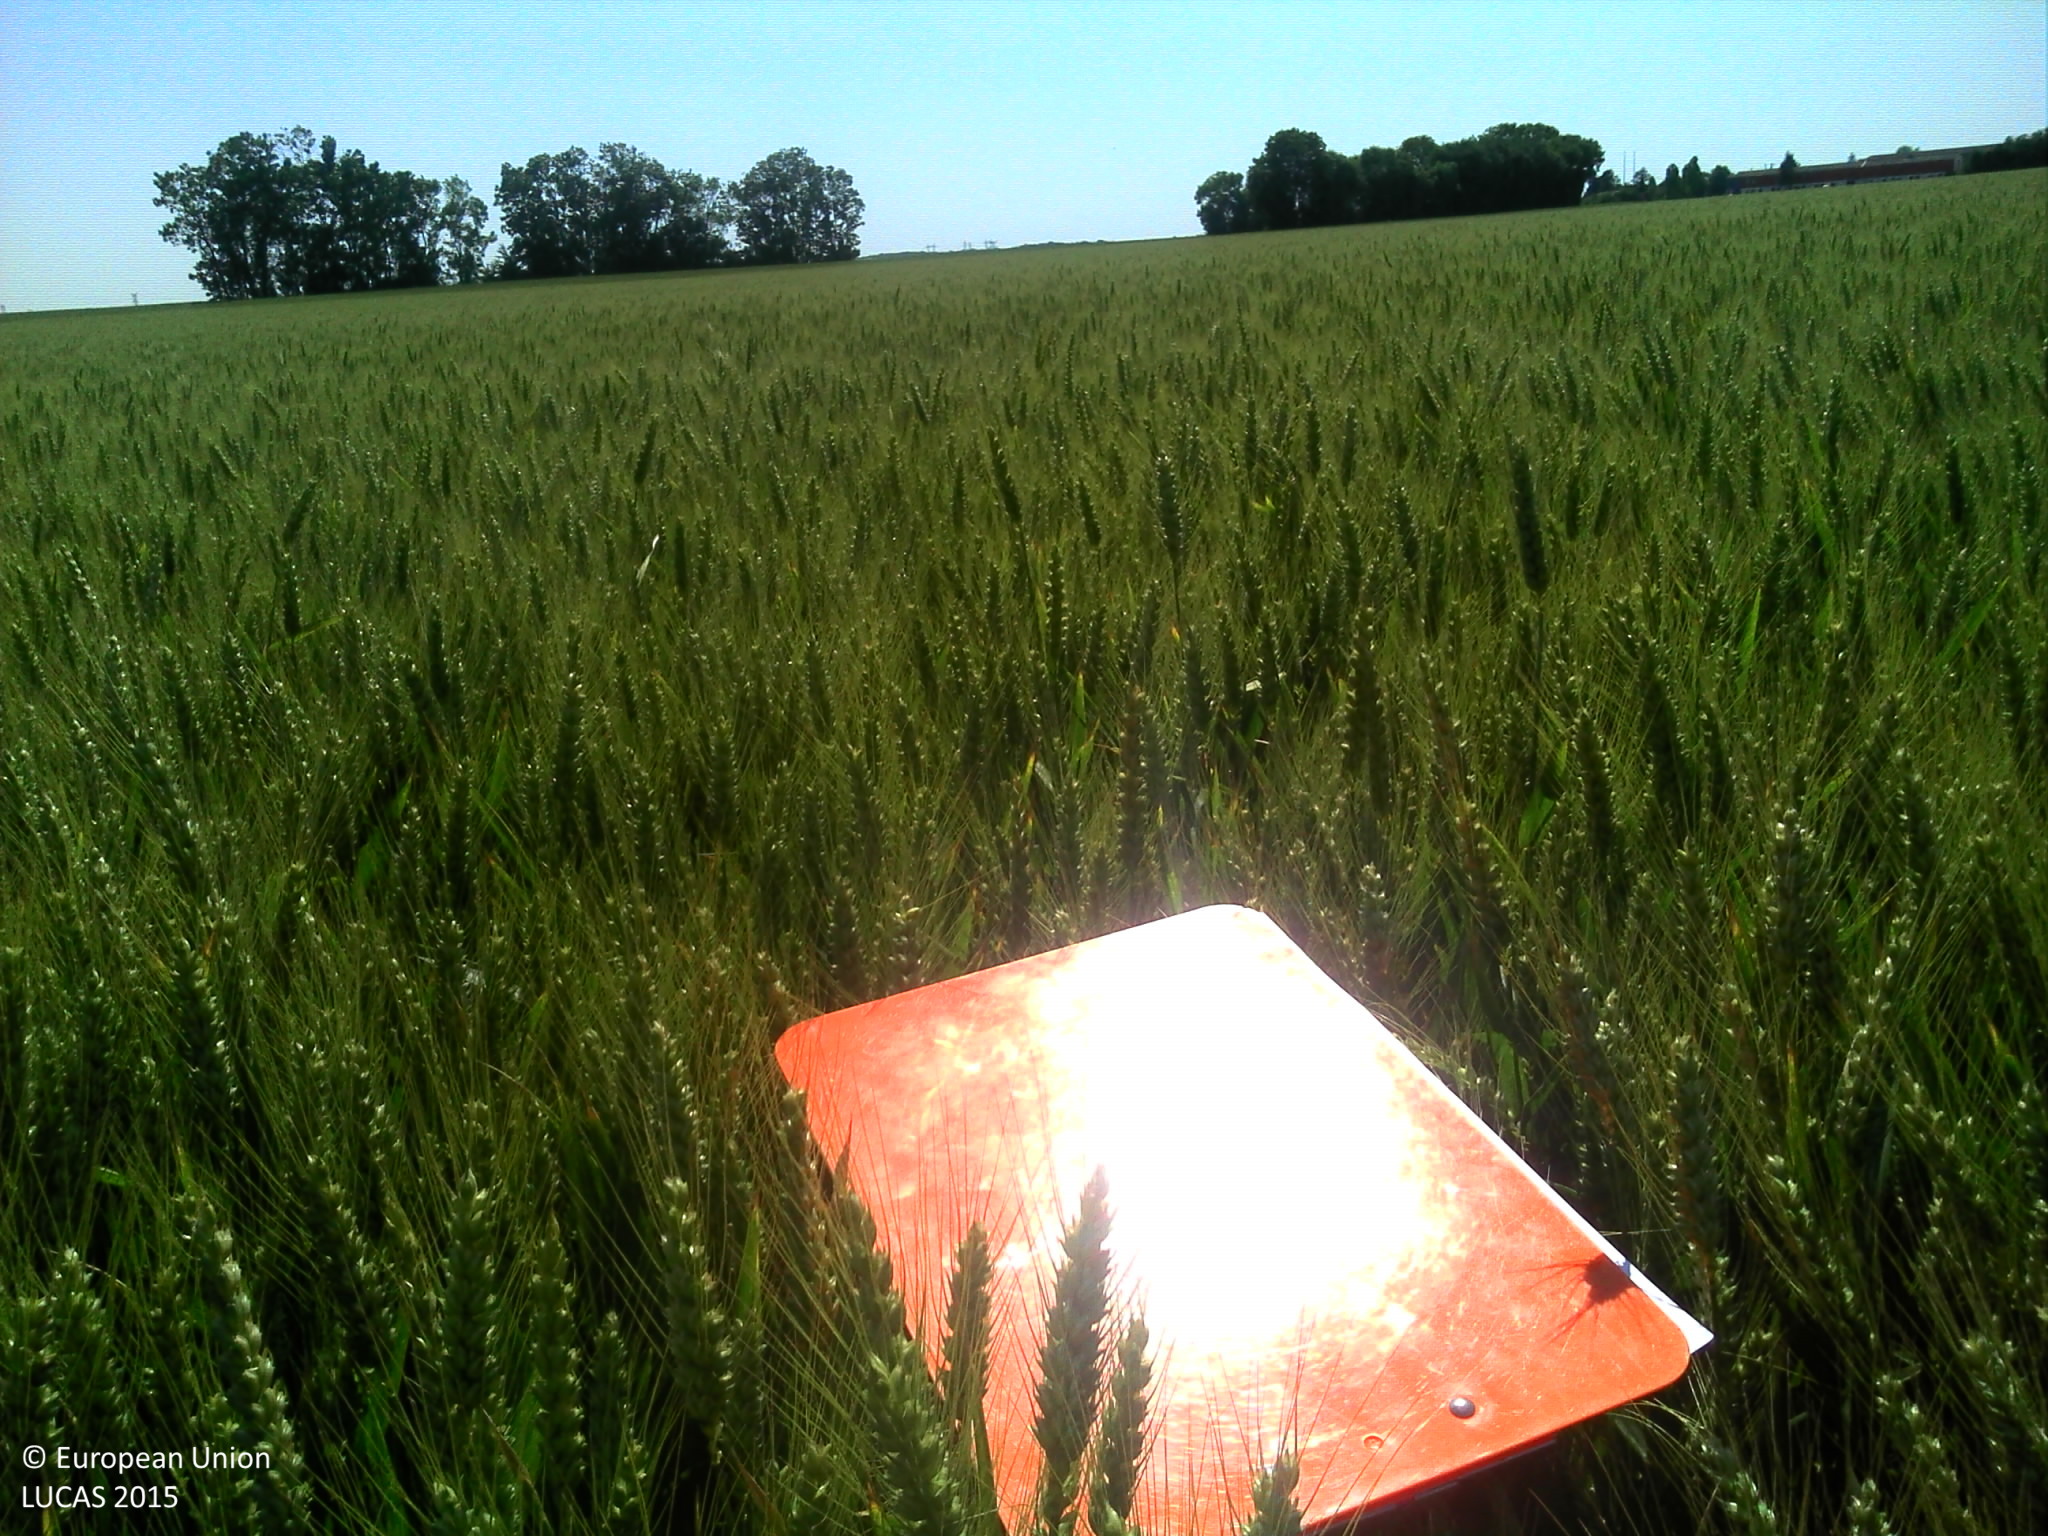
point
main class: Cropland
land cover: Durum wheat
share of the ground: > 75 %
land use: Agriculture (excluding fallow land and kitchen gardens)
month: June
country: FR
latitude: 46.1130
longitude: -0.9628
